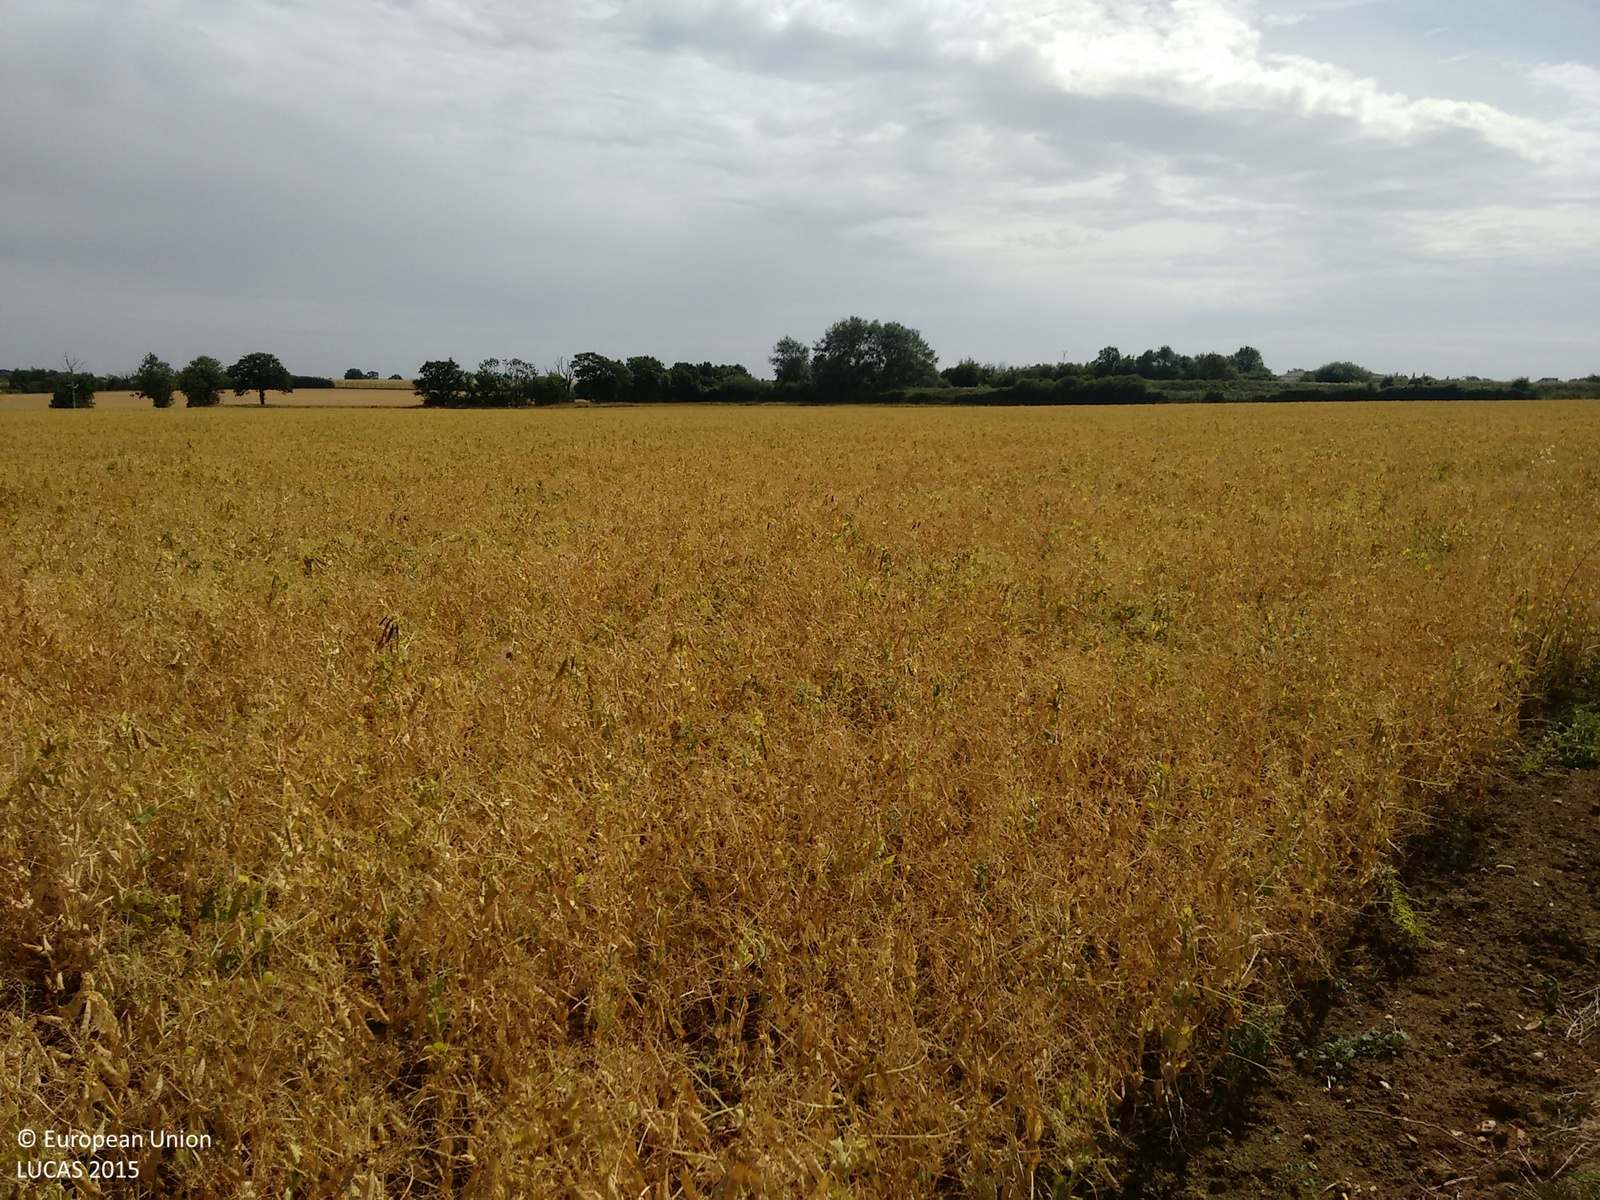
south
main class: Cropland
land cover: Dry pulses
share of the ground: > 75 %
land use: Agriculture (excluding fallow land and kitchen gardens)
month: August
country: GB
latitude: 51.9795
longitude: 0.5236
